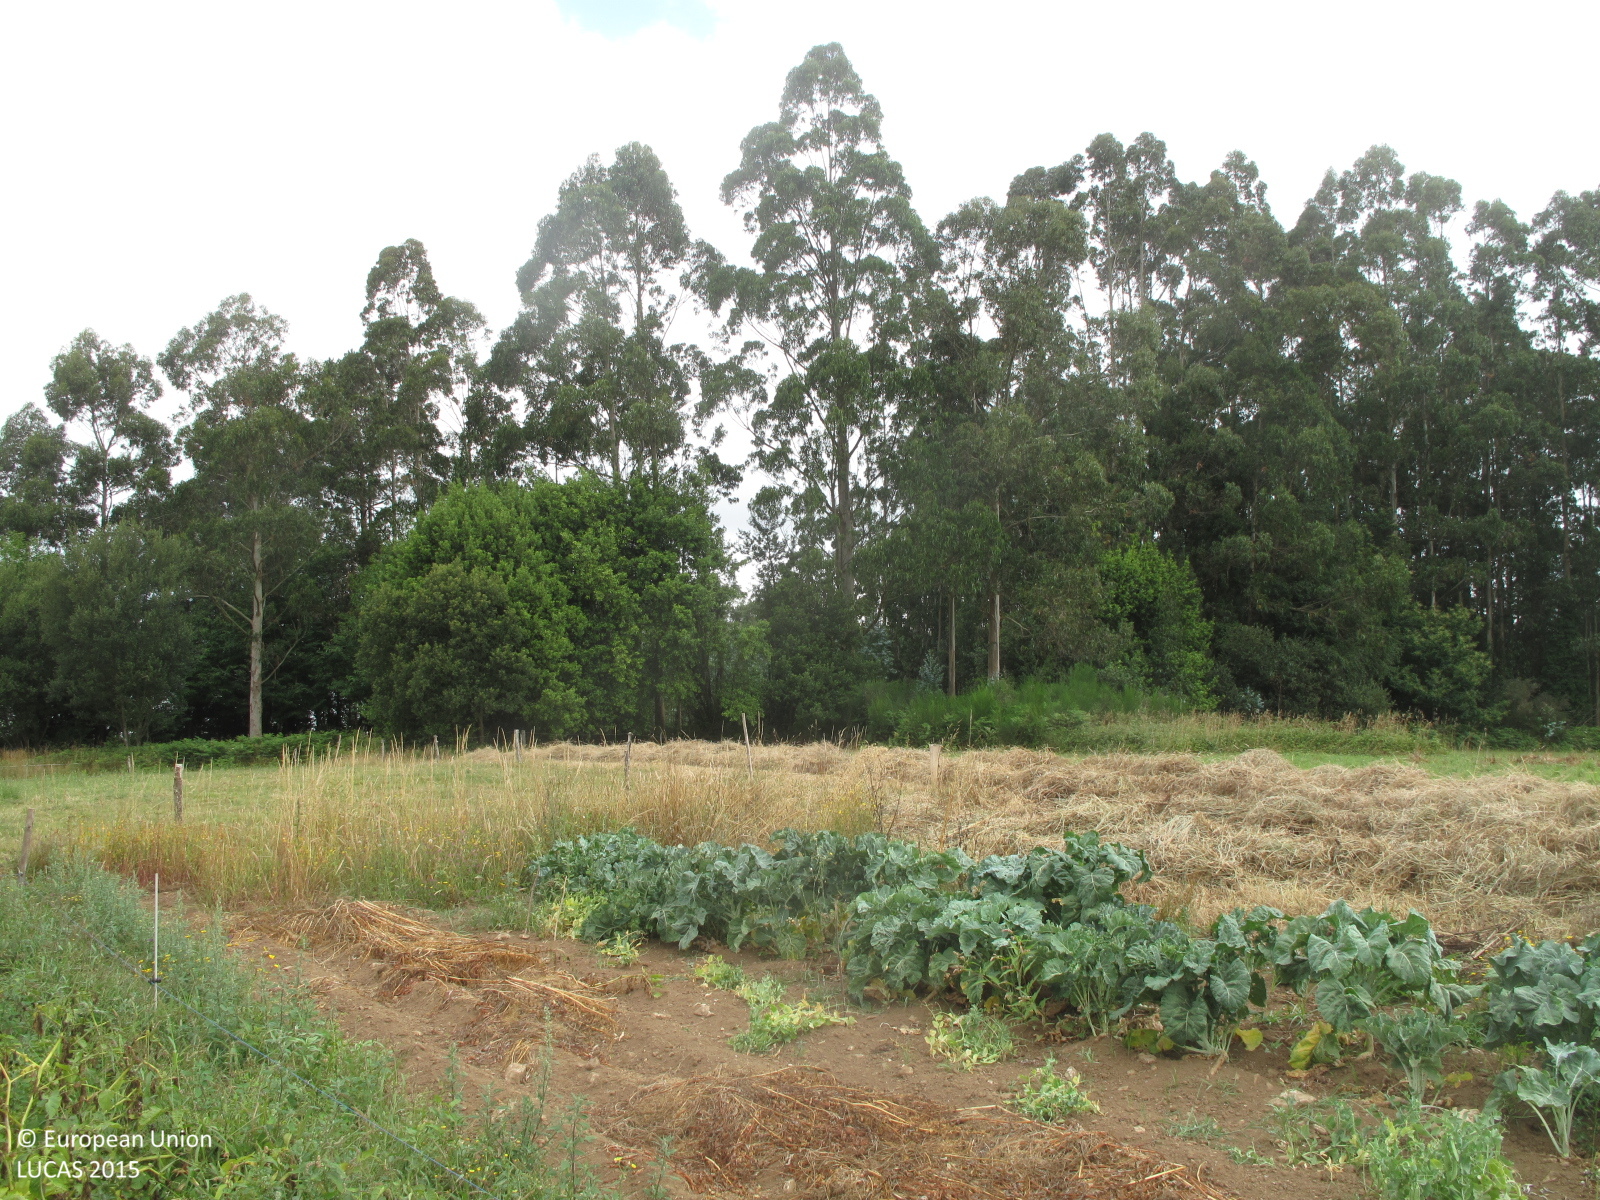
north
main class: Cropland
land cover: Potatoes
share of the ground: 25 - 50 %
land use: Kitchen garden
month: July
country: ES
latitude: 43.5960
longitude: -8.0732
